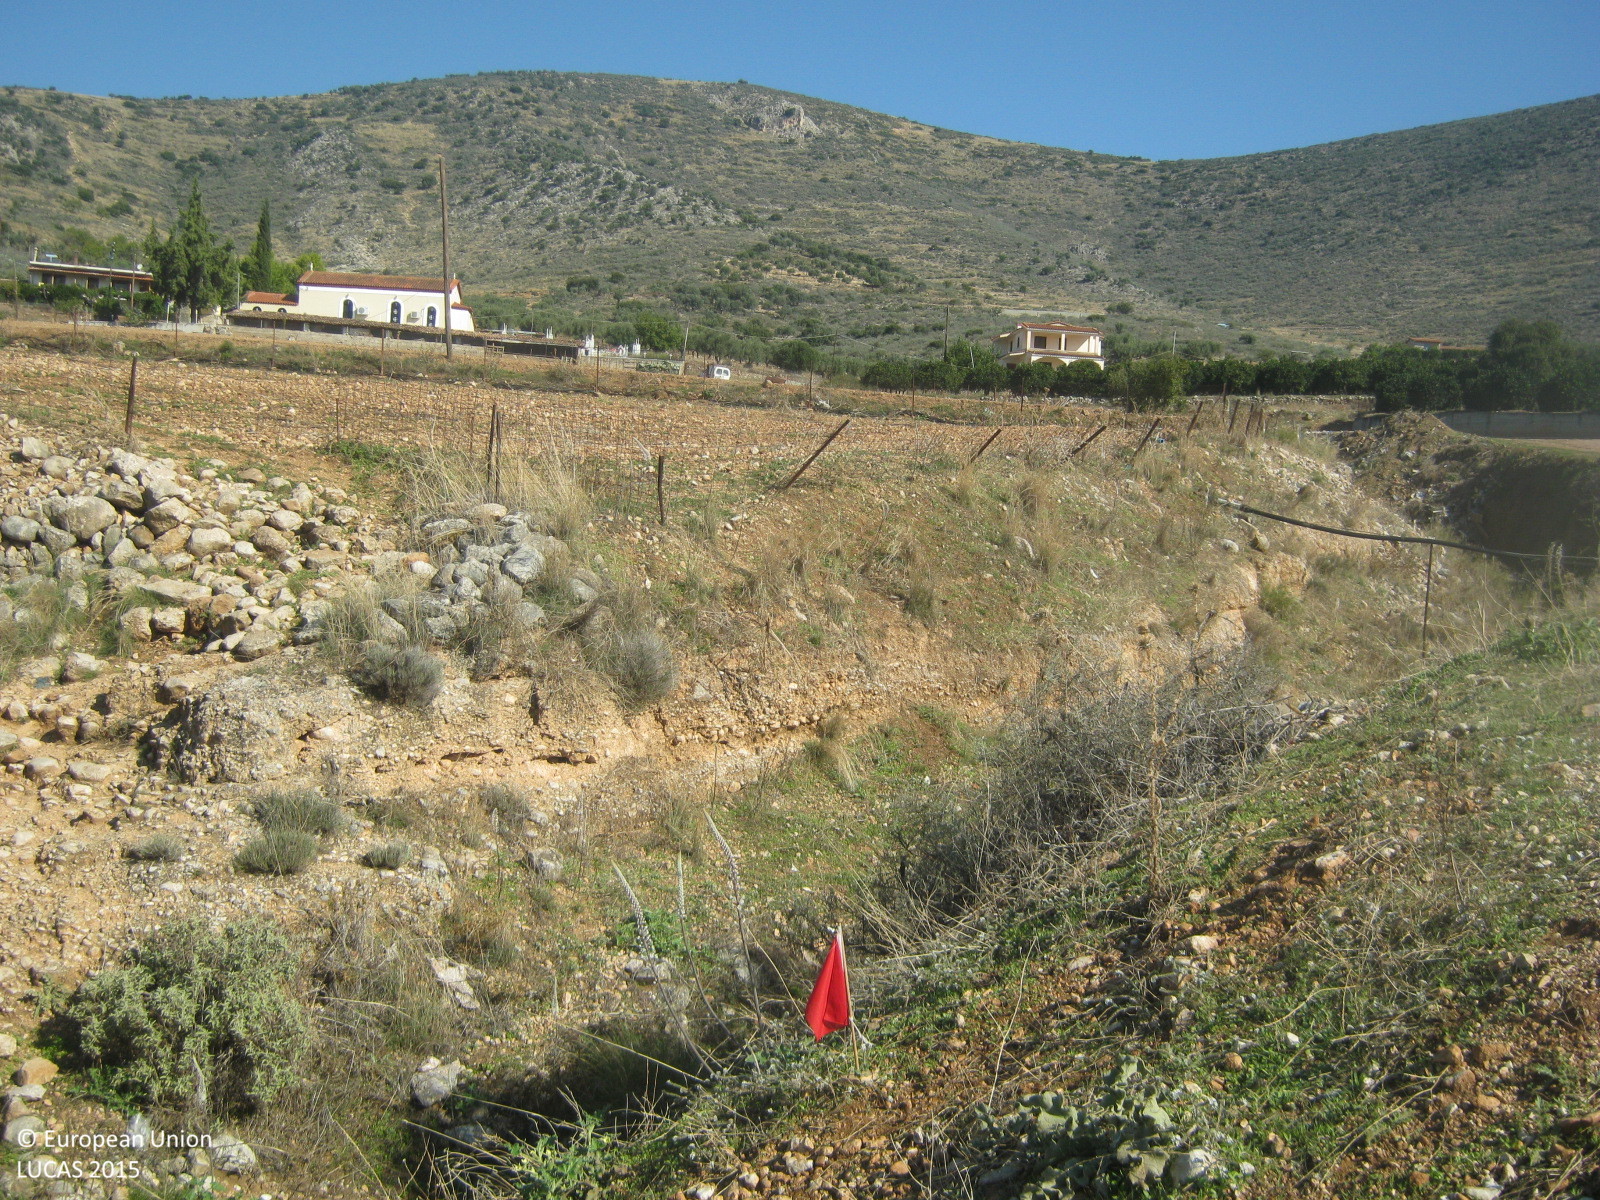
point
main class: Grassland
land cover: Grassland with sparse tree/shrub cover
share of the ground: 50 - 75 %
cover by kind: unconsolidated bare surface 55 %, herbaceous plants 30 %, shrubs 10 %, broadleaved forest trees 5 %
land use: Semi-natural and natural areas not in use
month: October
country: GR
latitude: 37.6803
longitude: 22.8373
